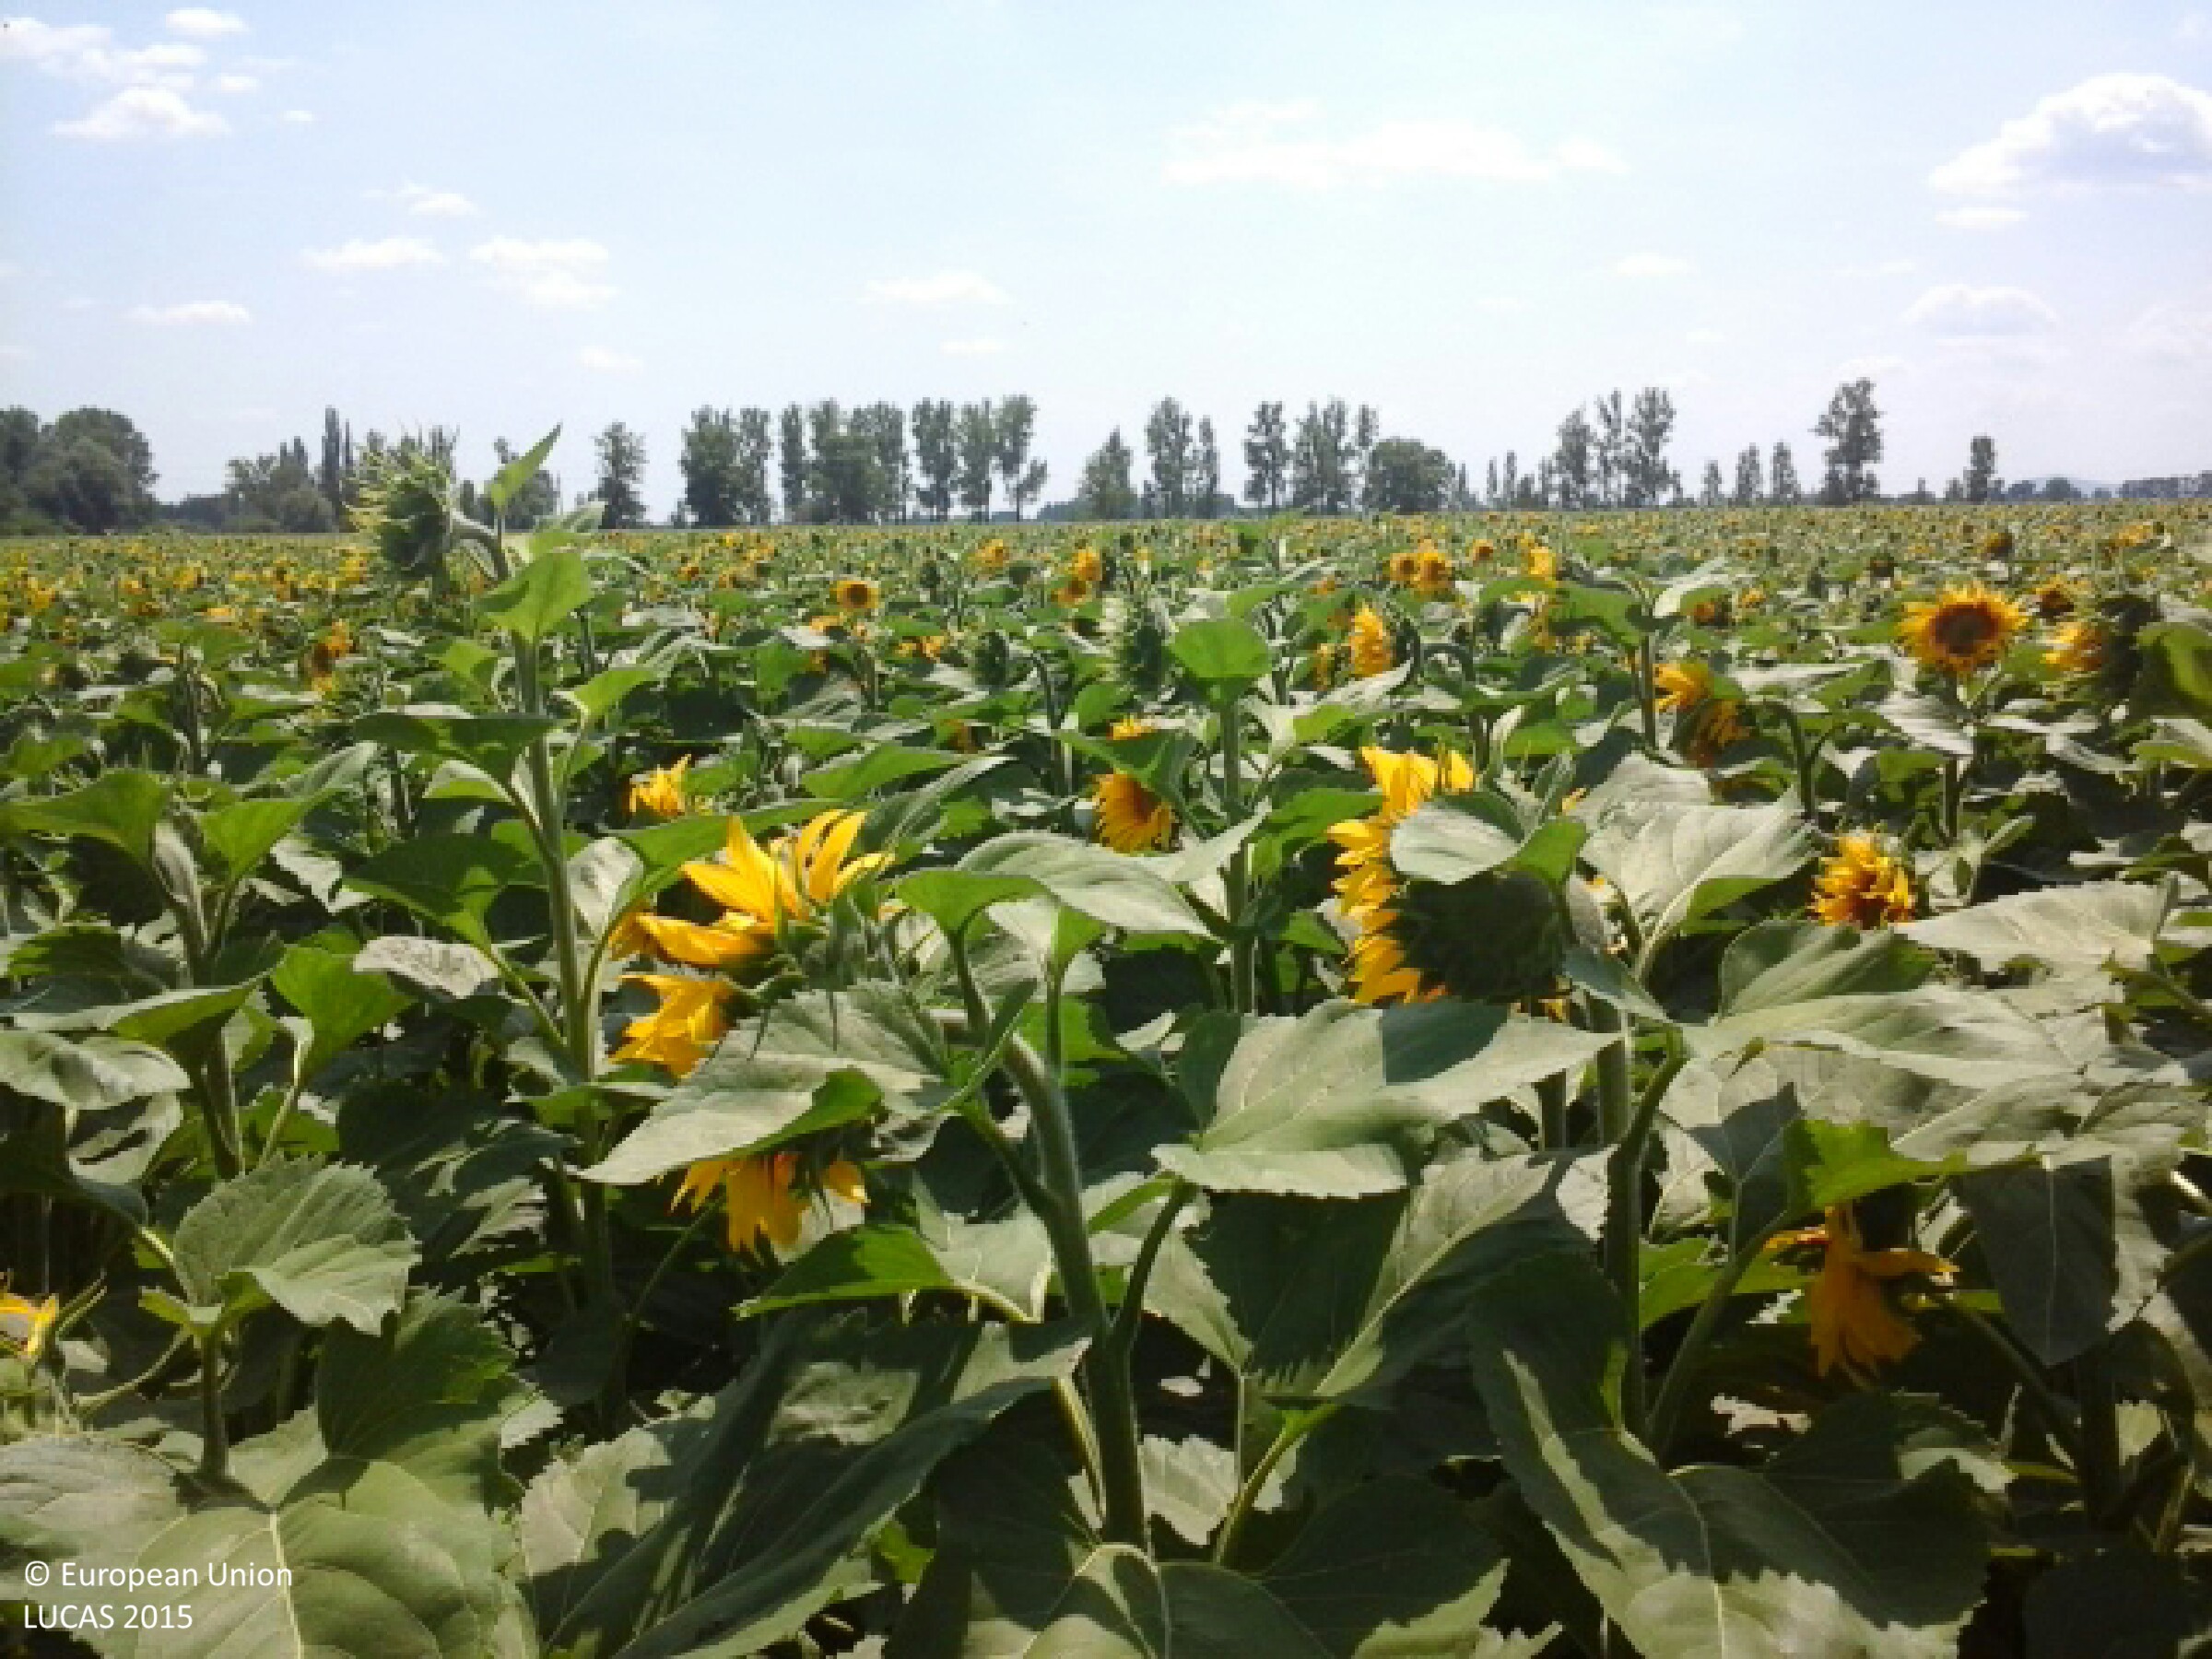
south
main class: Cropland
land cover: Sunflower
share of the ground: > 75 %
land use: Agriculture (excluding fallow land and kitchen gardens)
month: July
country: HU
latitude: 48.2995
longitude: 21.6006
